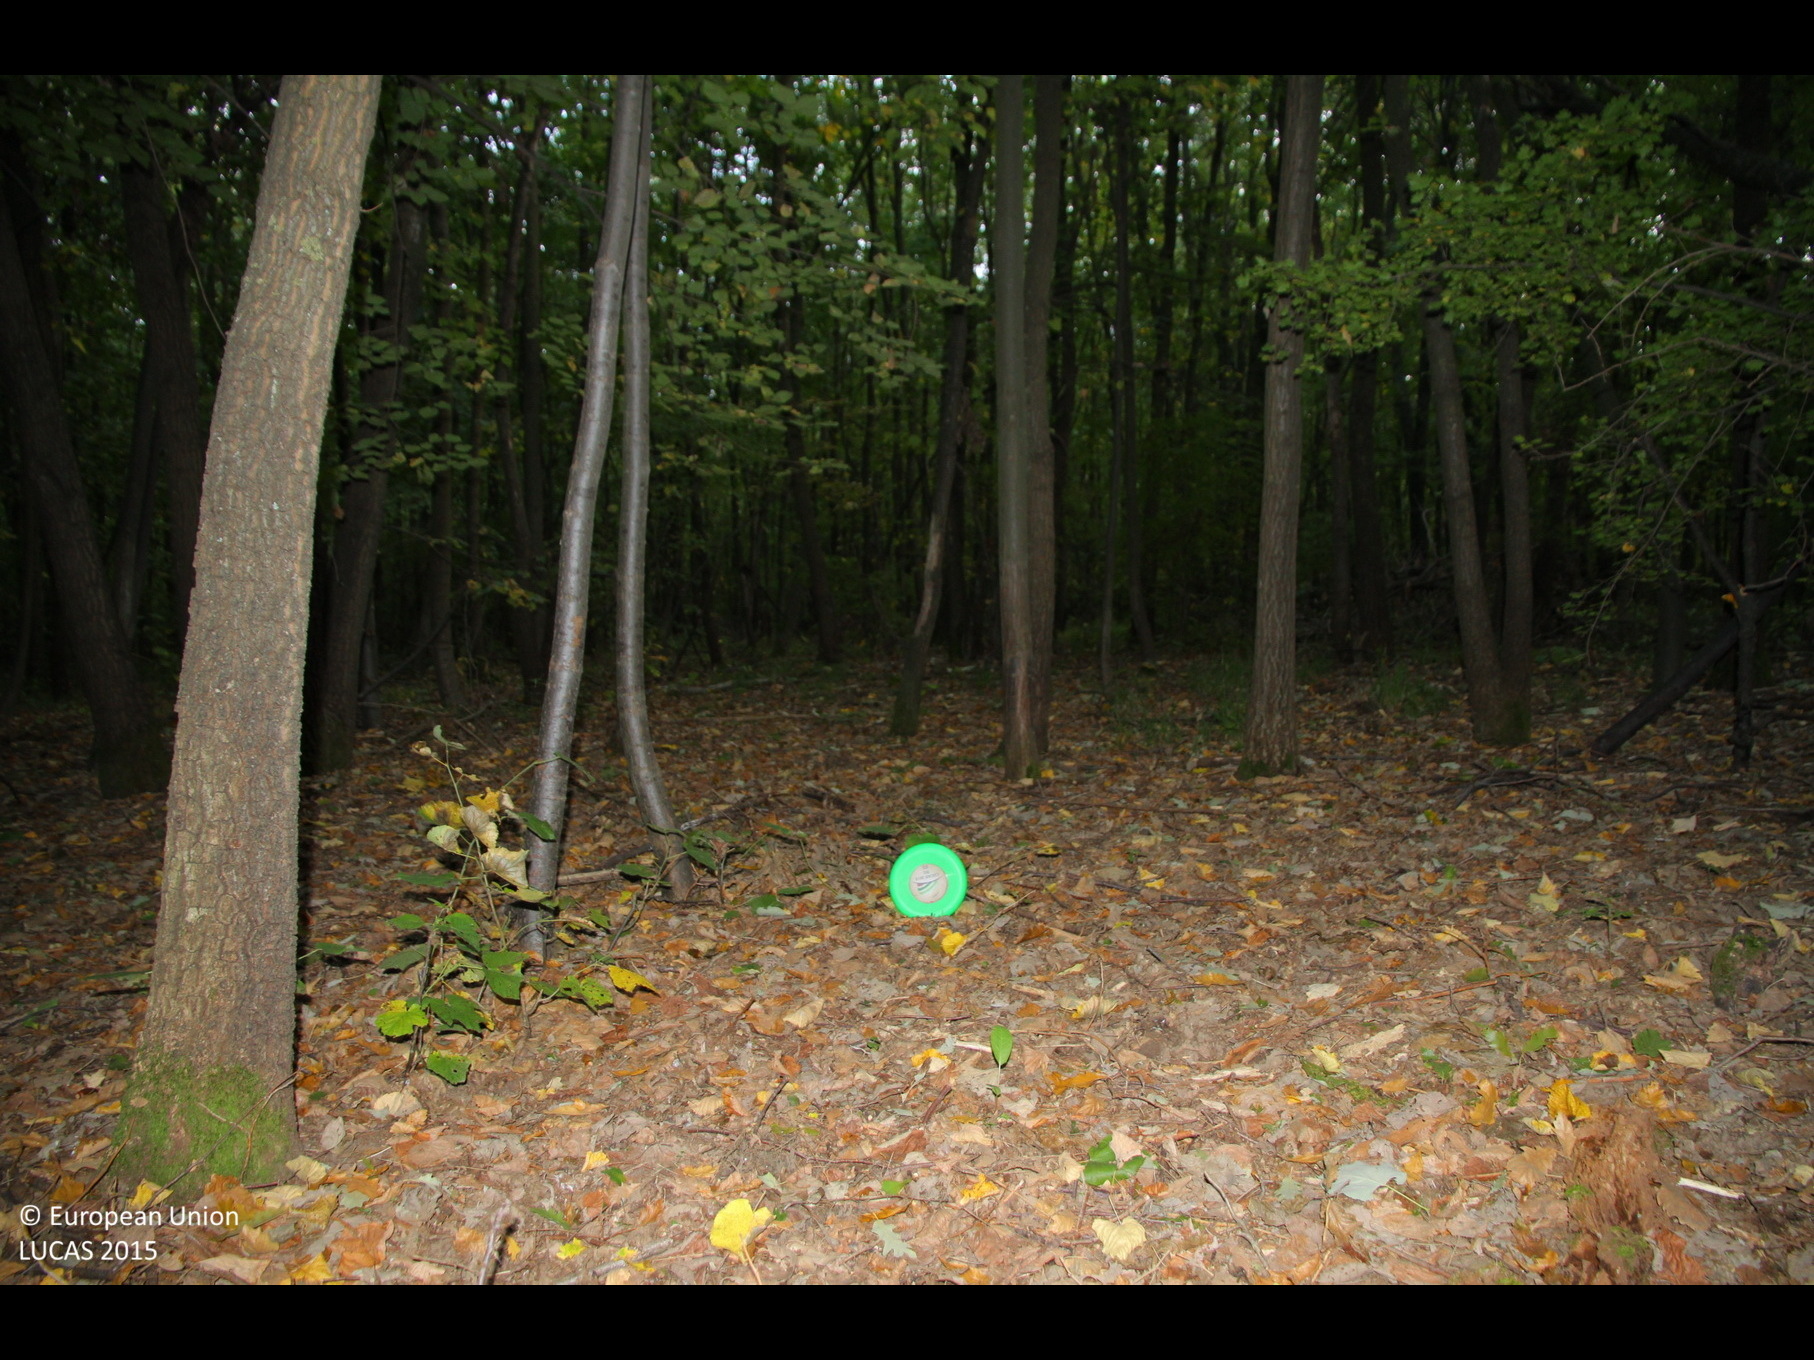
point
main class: Woodland
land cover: Broadleaved woodland
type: beech forest
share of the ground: > 75 %
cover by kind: broadleaved forest trees 100 %
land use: Forestry
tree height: > 5 m
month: October
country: BG
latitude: 43.5470
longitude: 27.1911
